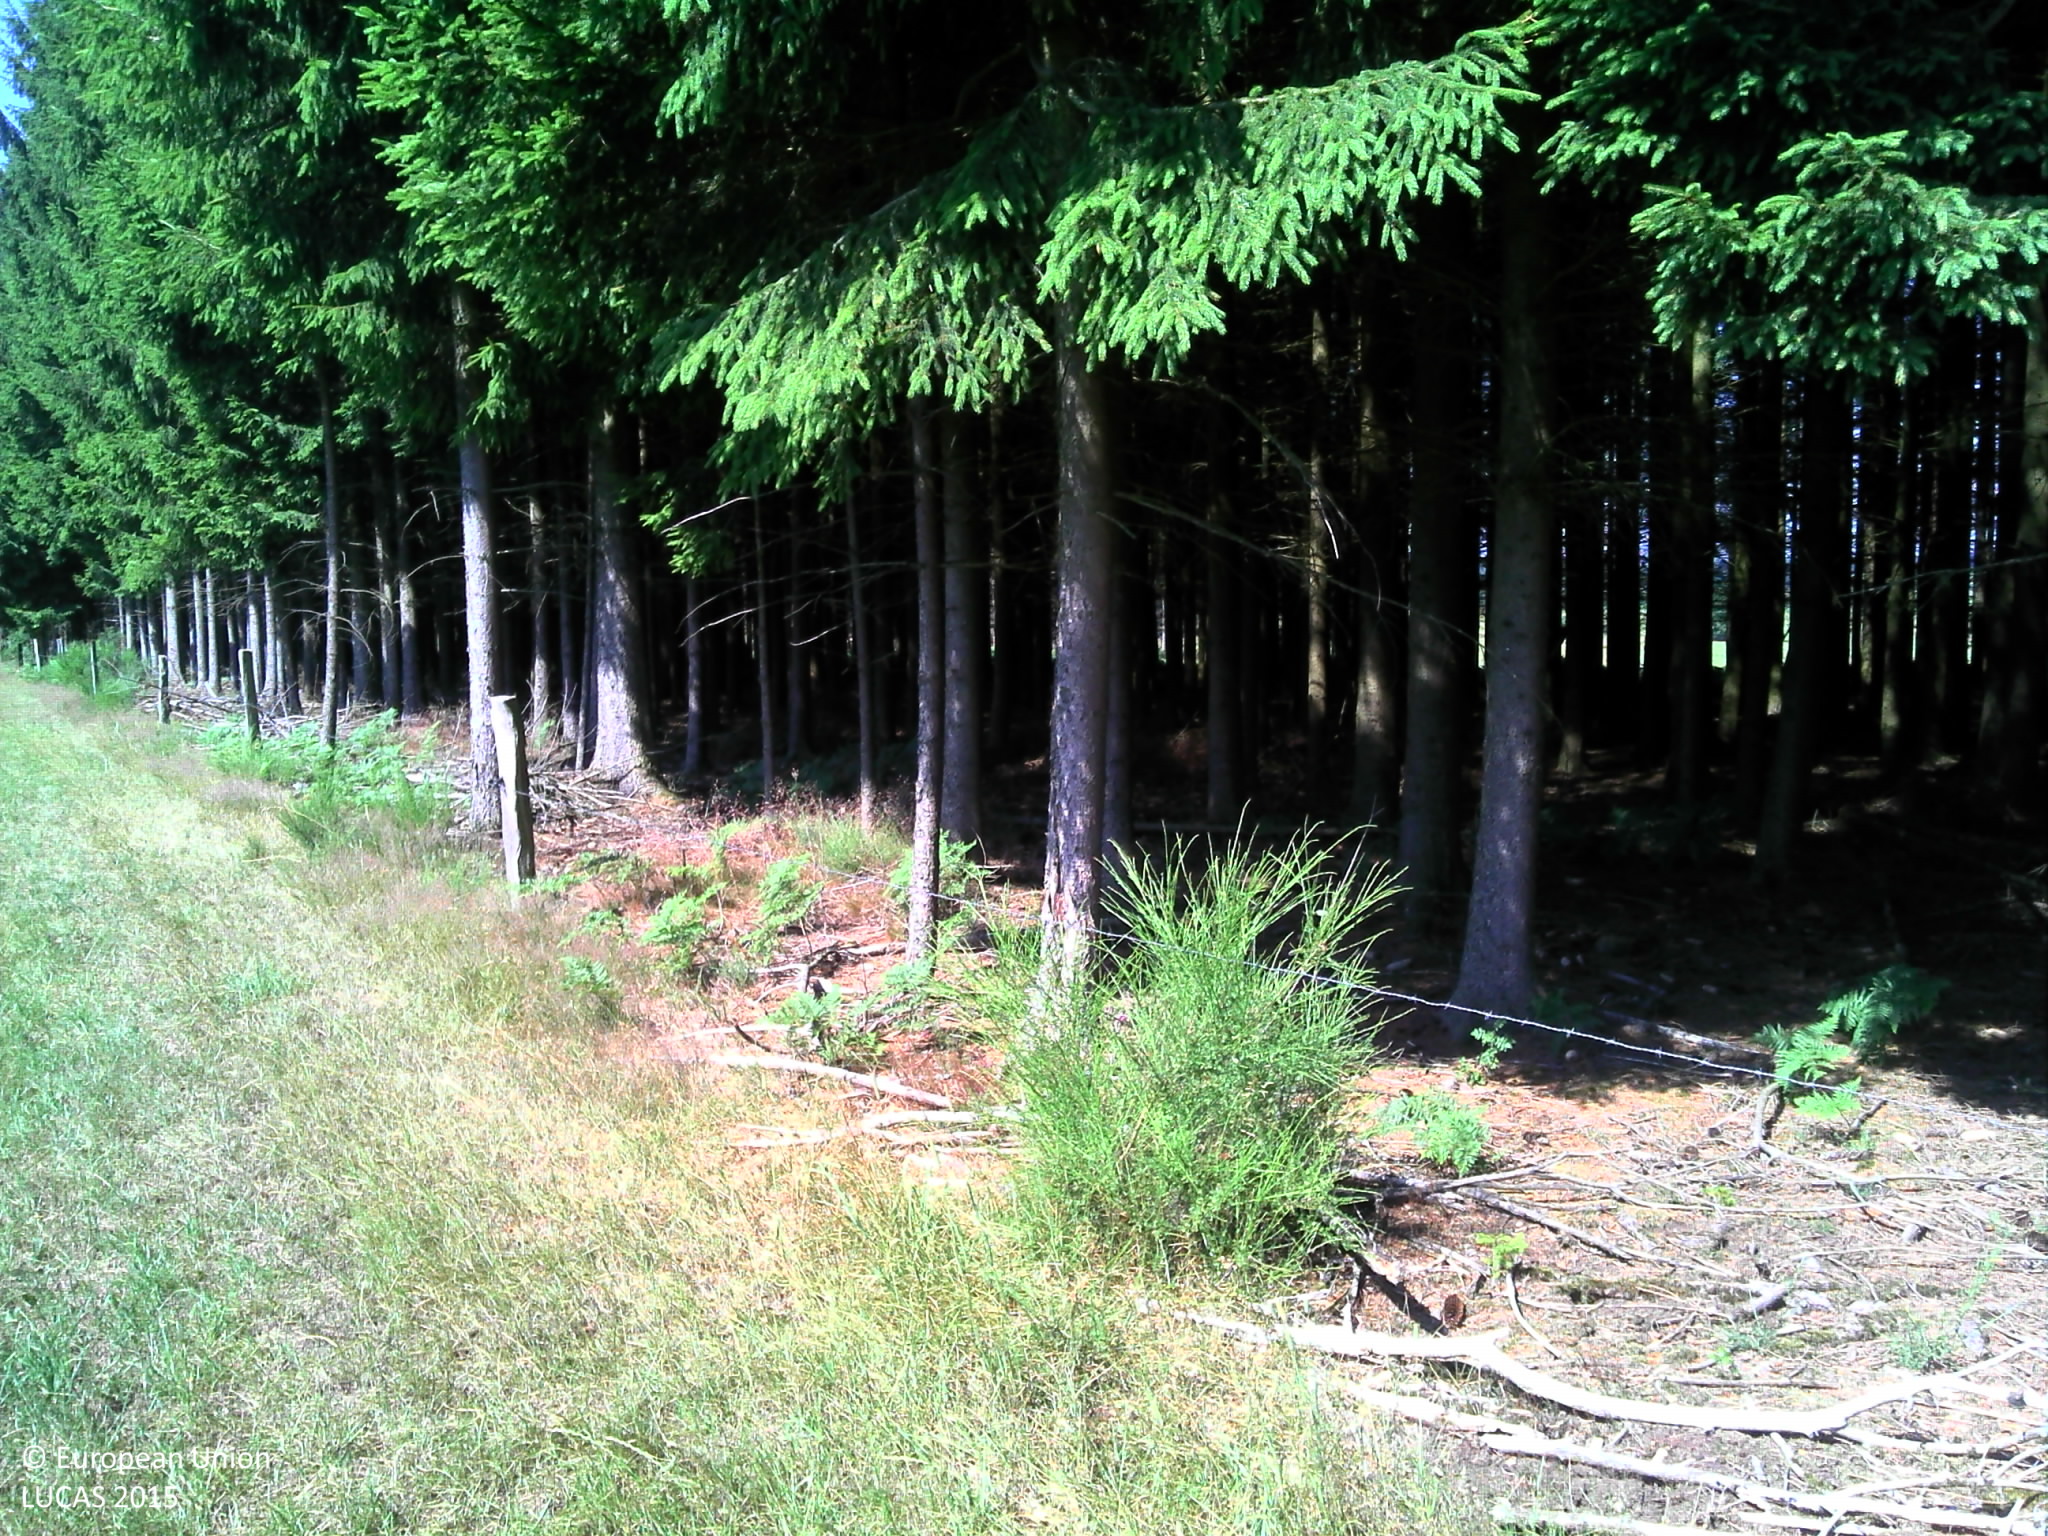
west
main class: Grassland
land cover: Grassland without tree/shrub cover
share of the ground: > 75 %
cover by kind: herbaceous plants 100 %
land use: Agriculture (excluding fallow land and kitchen gardens)
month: July
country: BE
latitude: 50.0517
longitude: 5.7670
